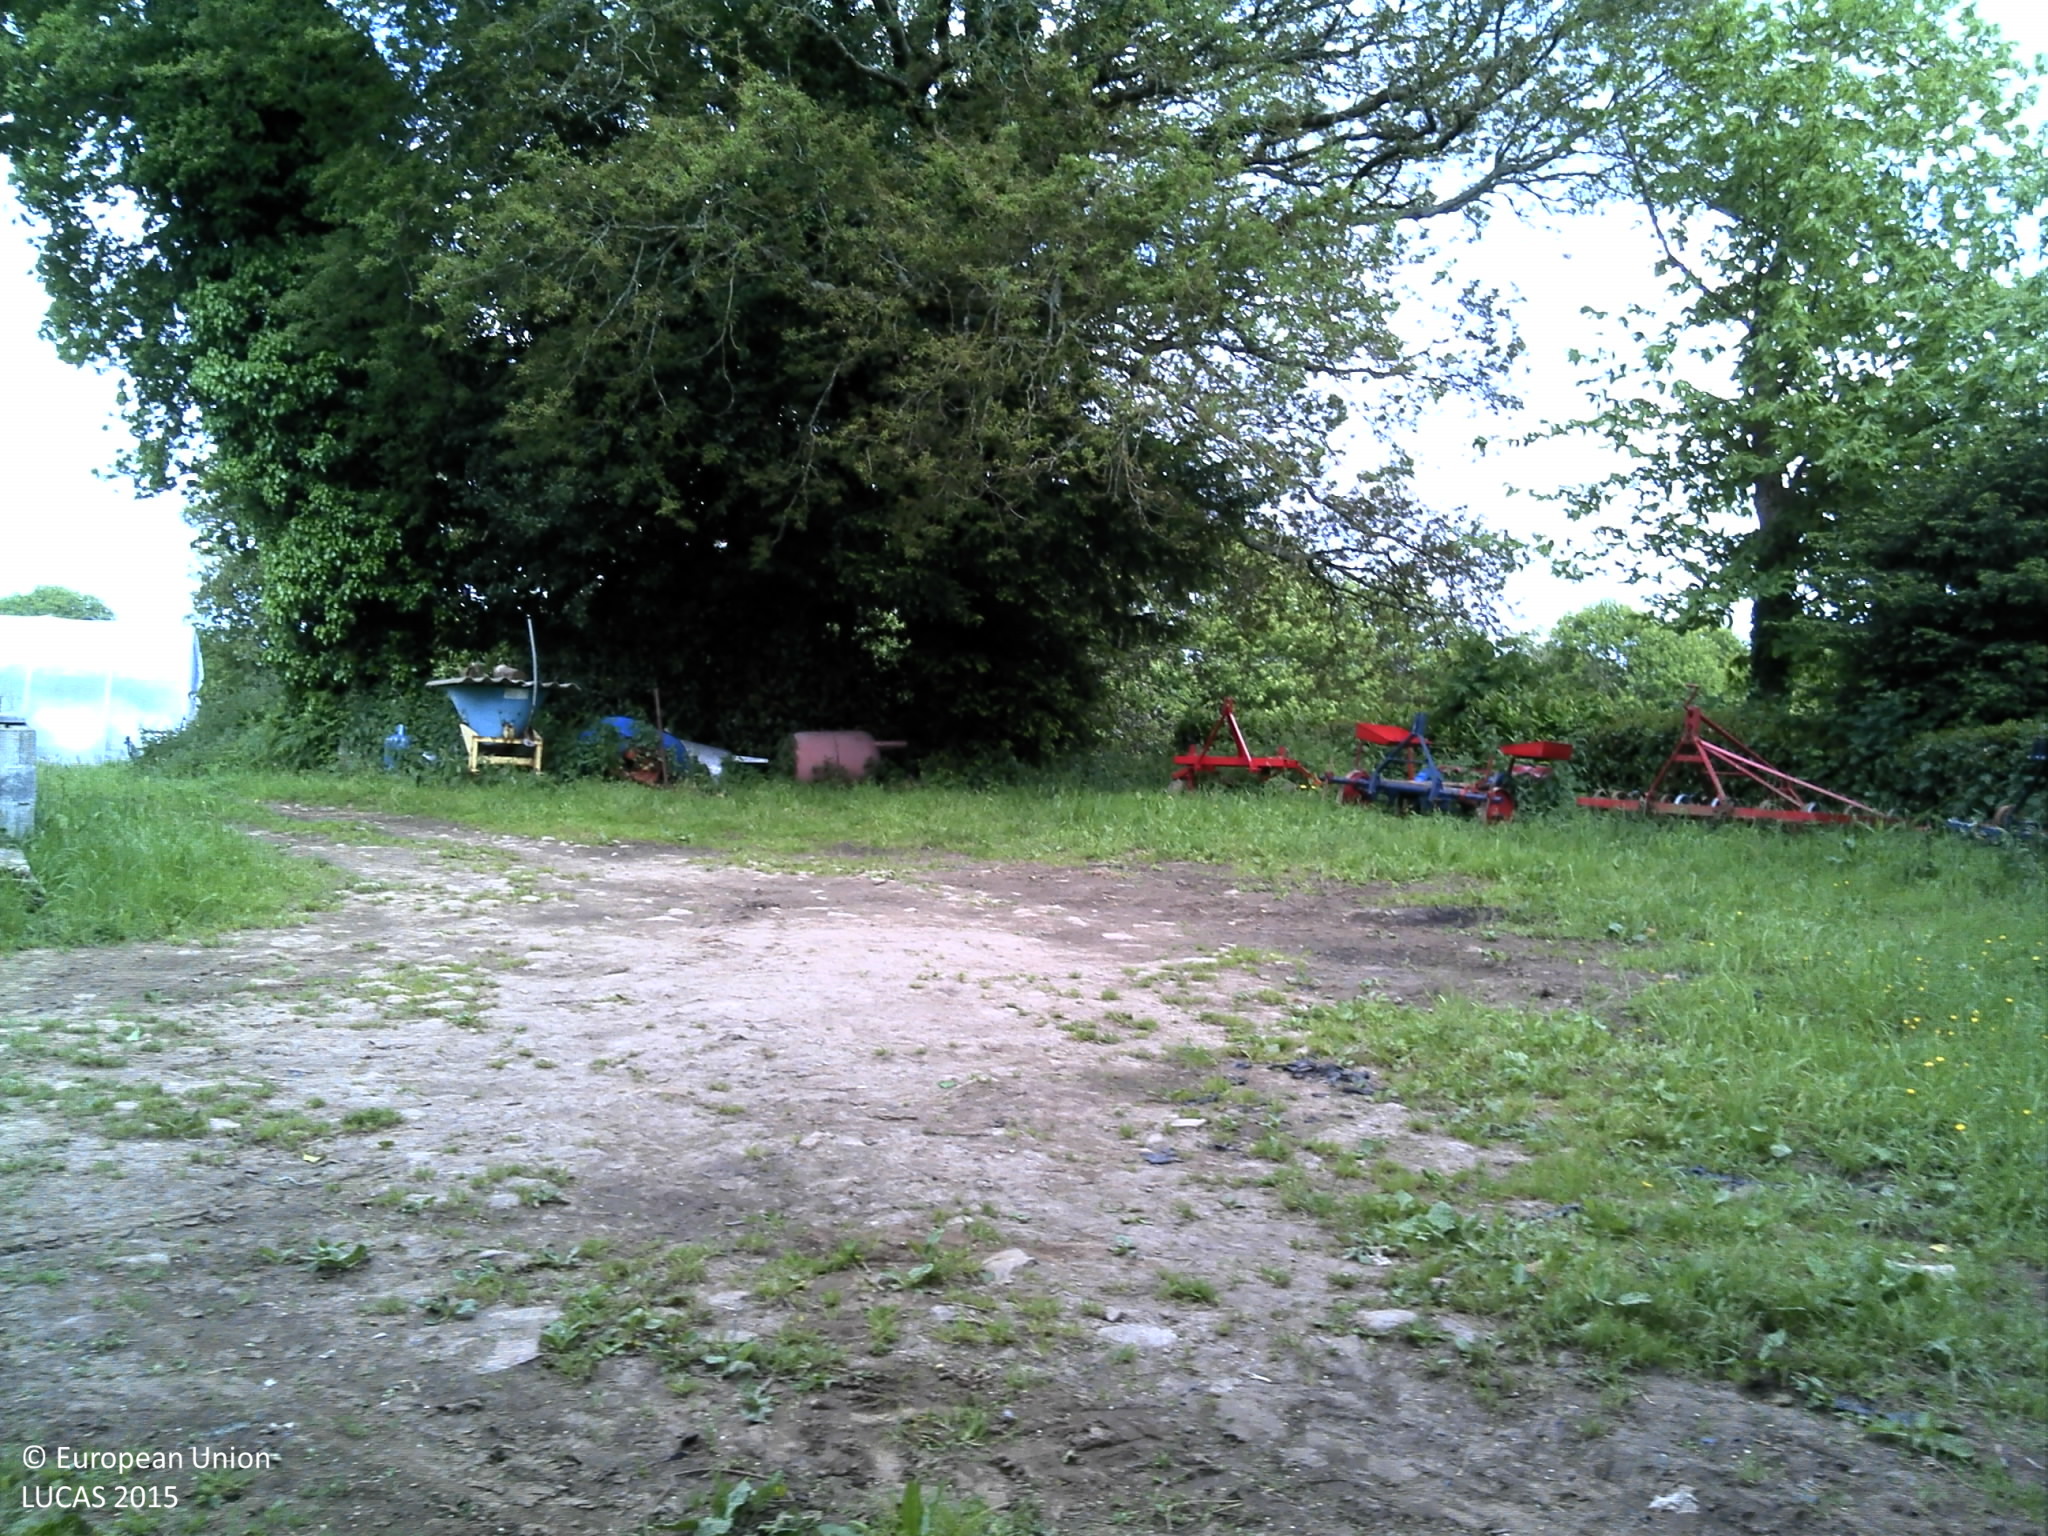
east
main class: Grassland
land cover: Grassland without tree/shrub cover
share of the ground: > 75 %
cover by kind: herbaceous plants 100 %
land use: Residential
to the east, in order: Grassland without tree/shrub cover; Managed hedges; Artificial constructions in urban areas; Grassland with sparse tree/shrub cover; Broadleaved woodland; Tracks; Other bare soil; Maize
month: June
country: FR
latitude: 47.9399
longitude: -3.6127
